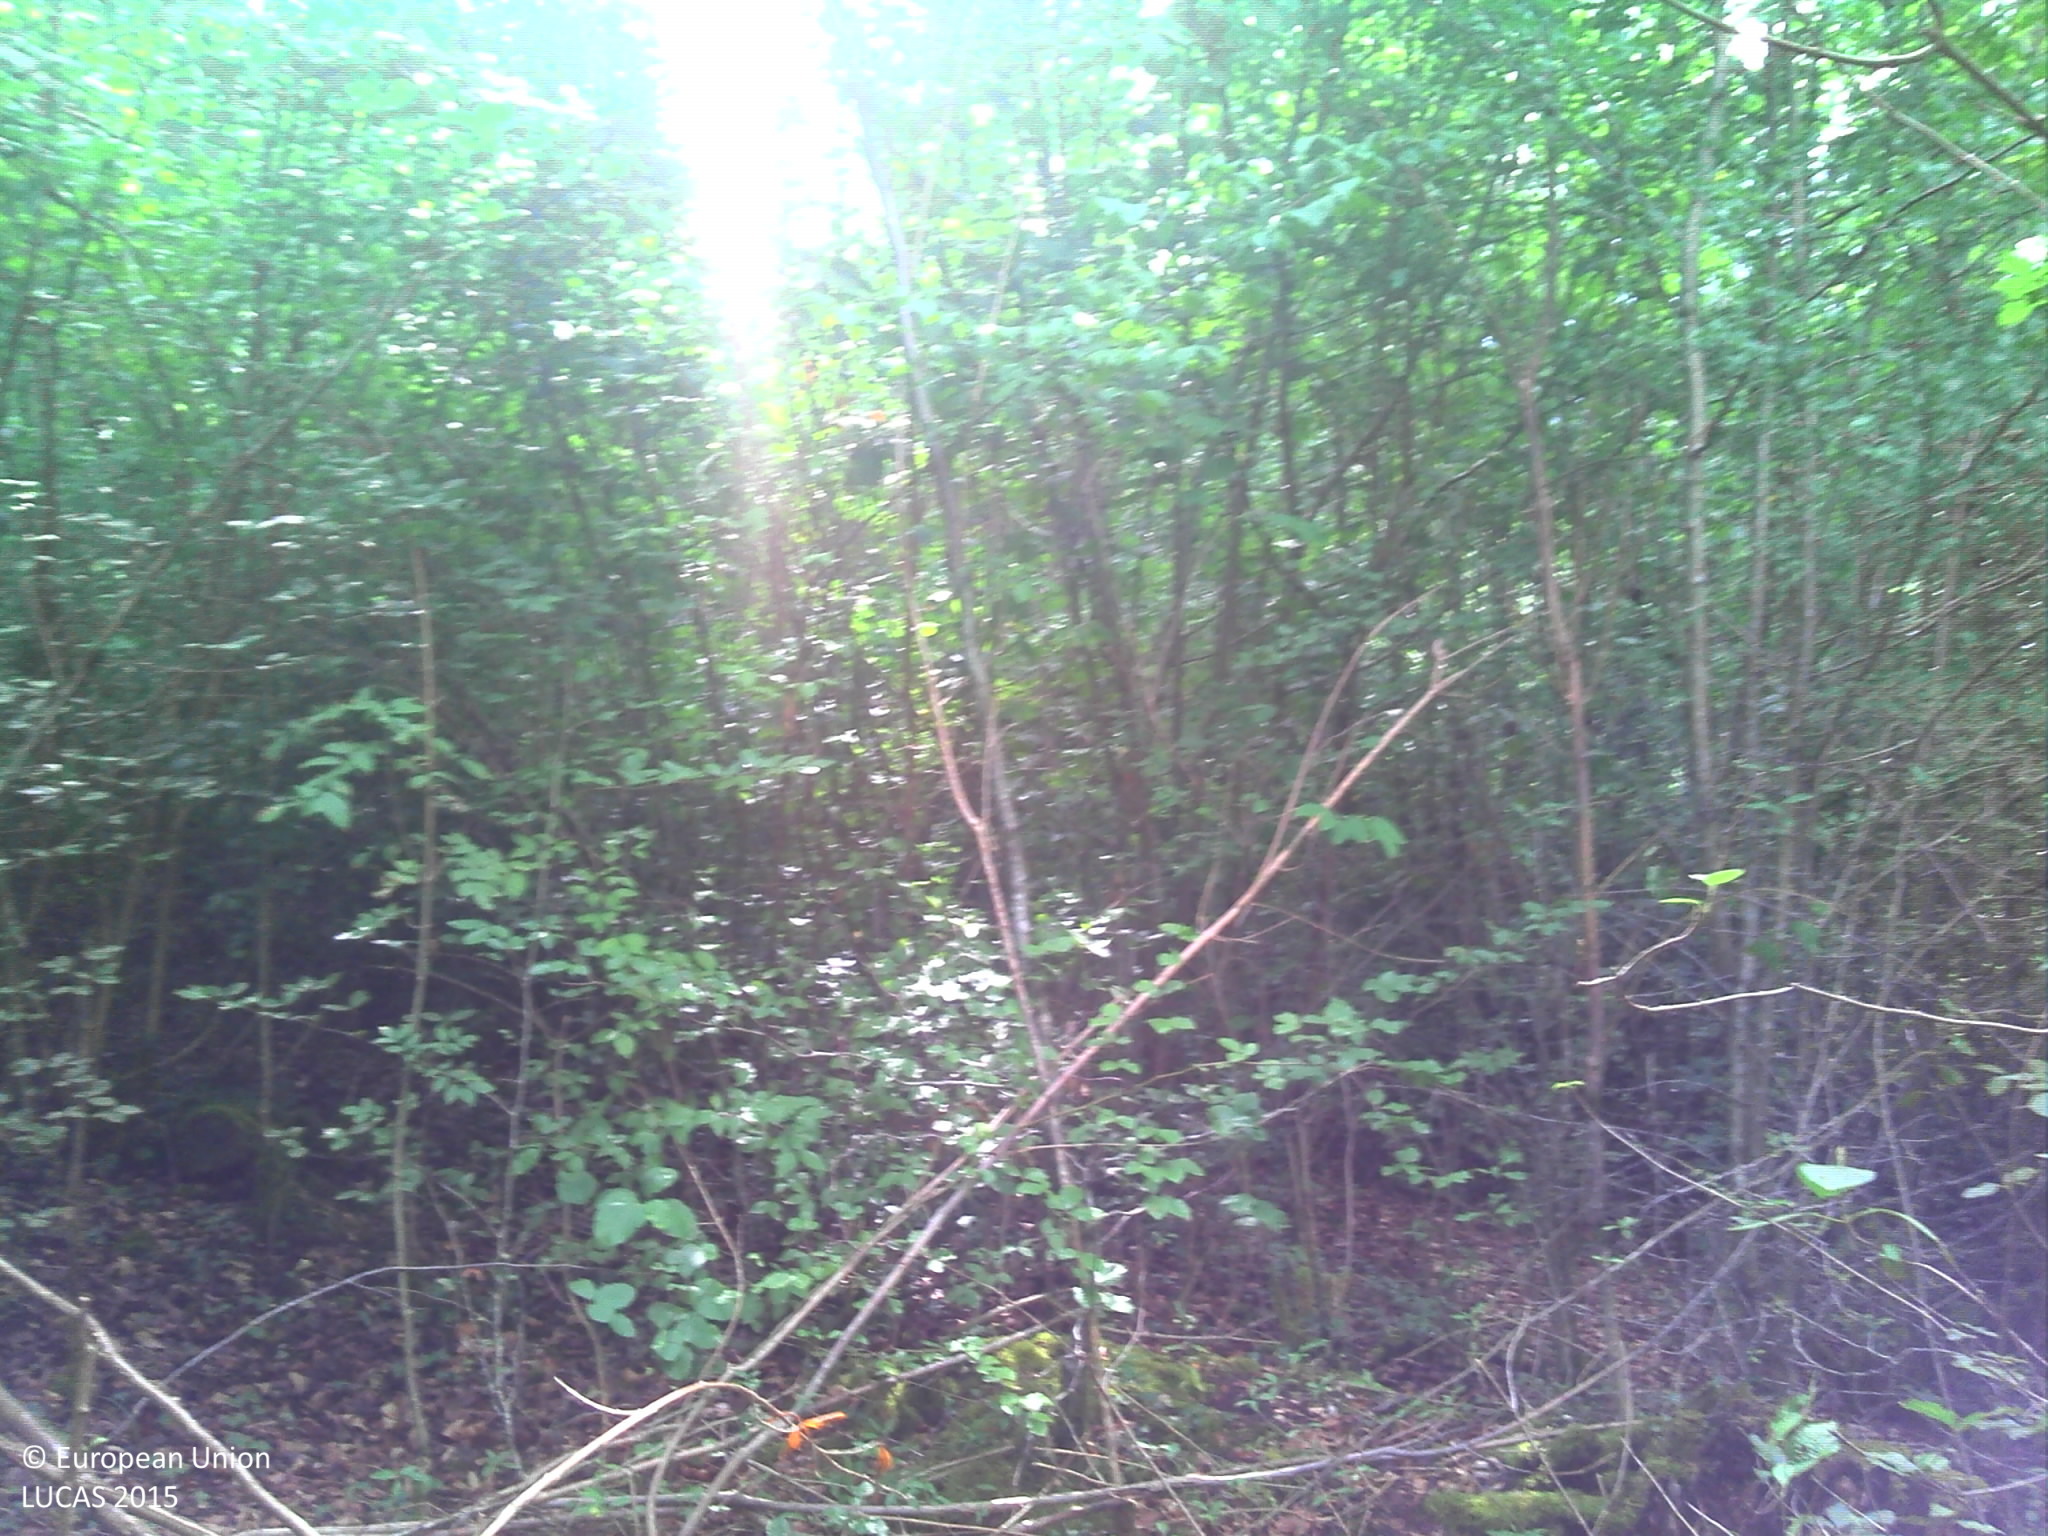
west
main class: Woodland
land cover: Broadleaved woodland
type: mesophytic deciduous forest
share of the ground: > 75 %
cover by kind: broadleaved forest trees 90 %, herbaceous plants 5 %, lichens and mosses 5 %
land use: Forestry
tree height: < 5 m
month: August
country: FR
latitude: 47.8045
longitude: 5.0191
